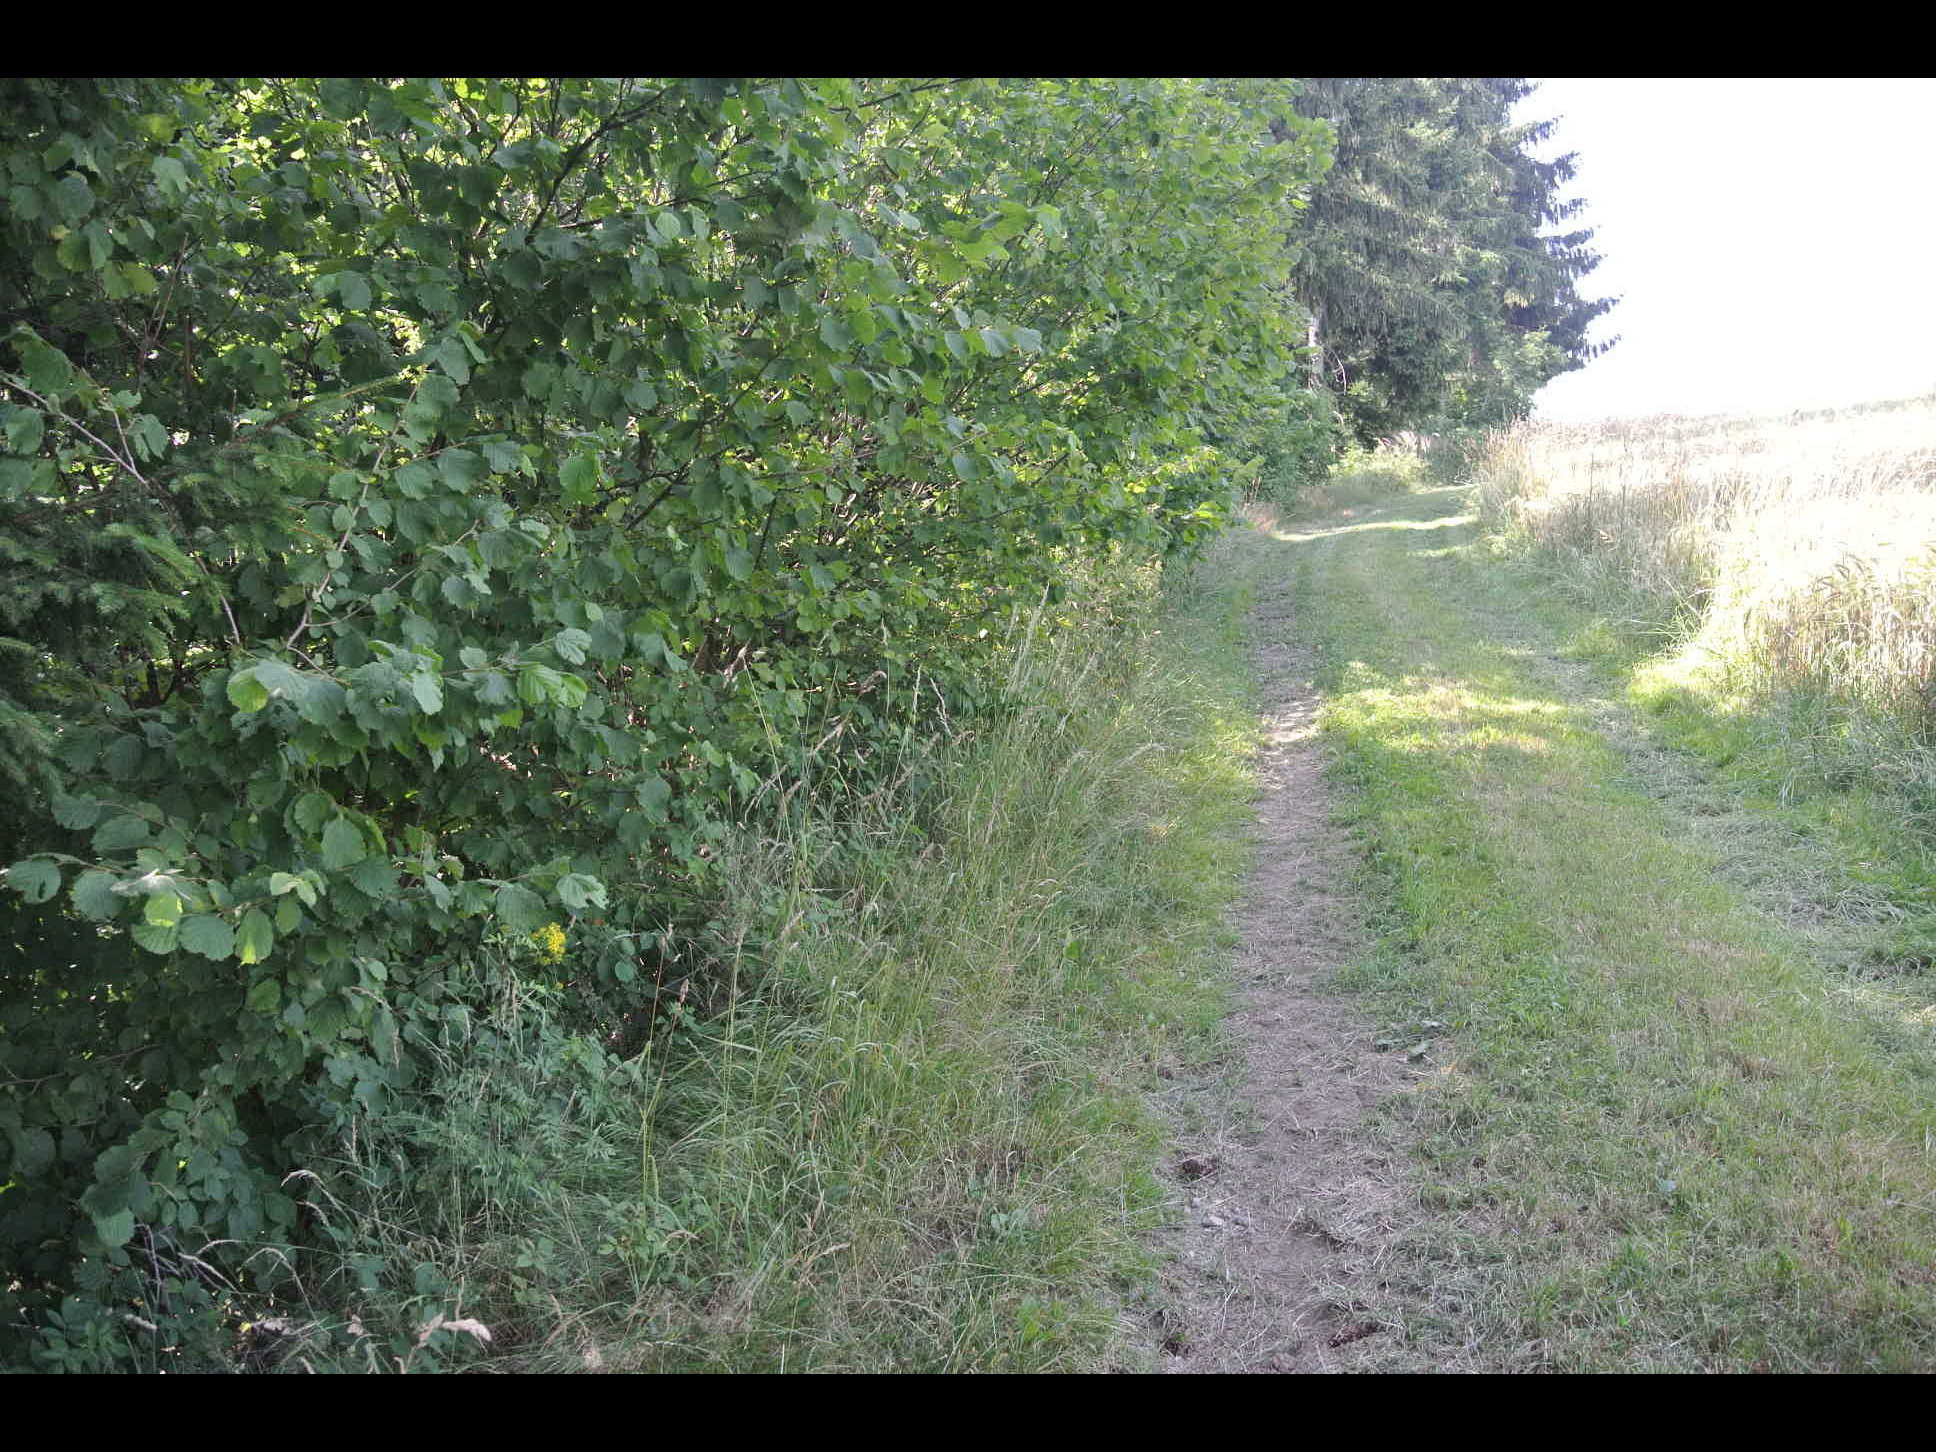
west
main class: Woodland
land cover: Broadleaved woodland
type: floodplain forest
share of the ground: > 75 %
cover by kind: broadleaved forest trees 100 %
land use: Forestry
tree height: > 5 m
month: July
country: AT
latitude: 47.5626
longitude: 16.1832
